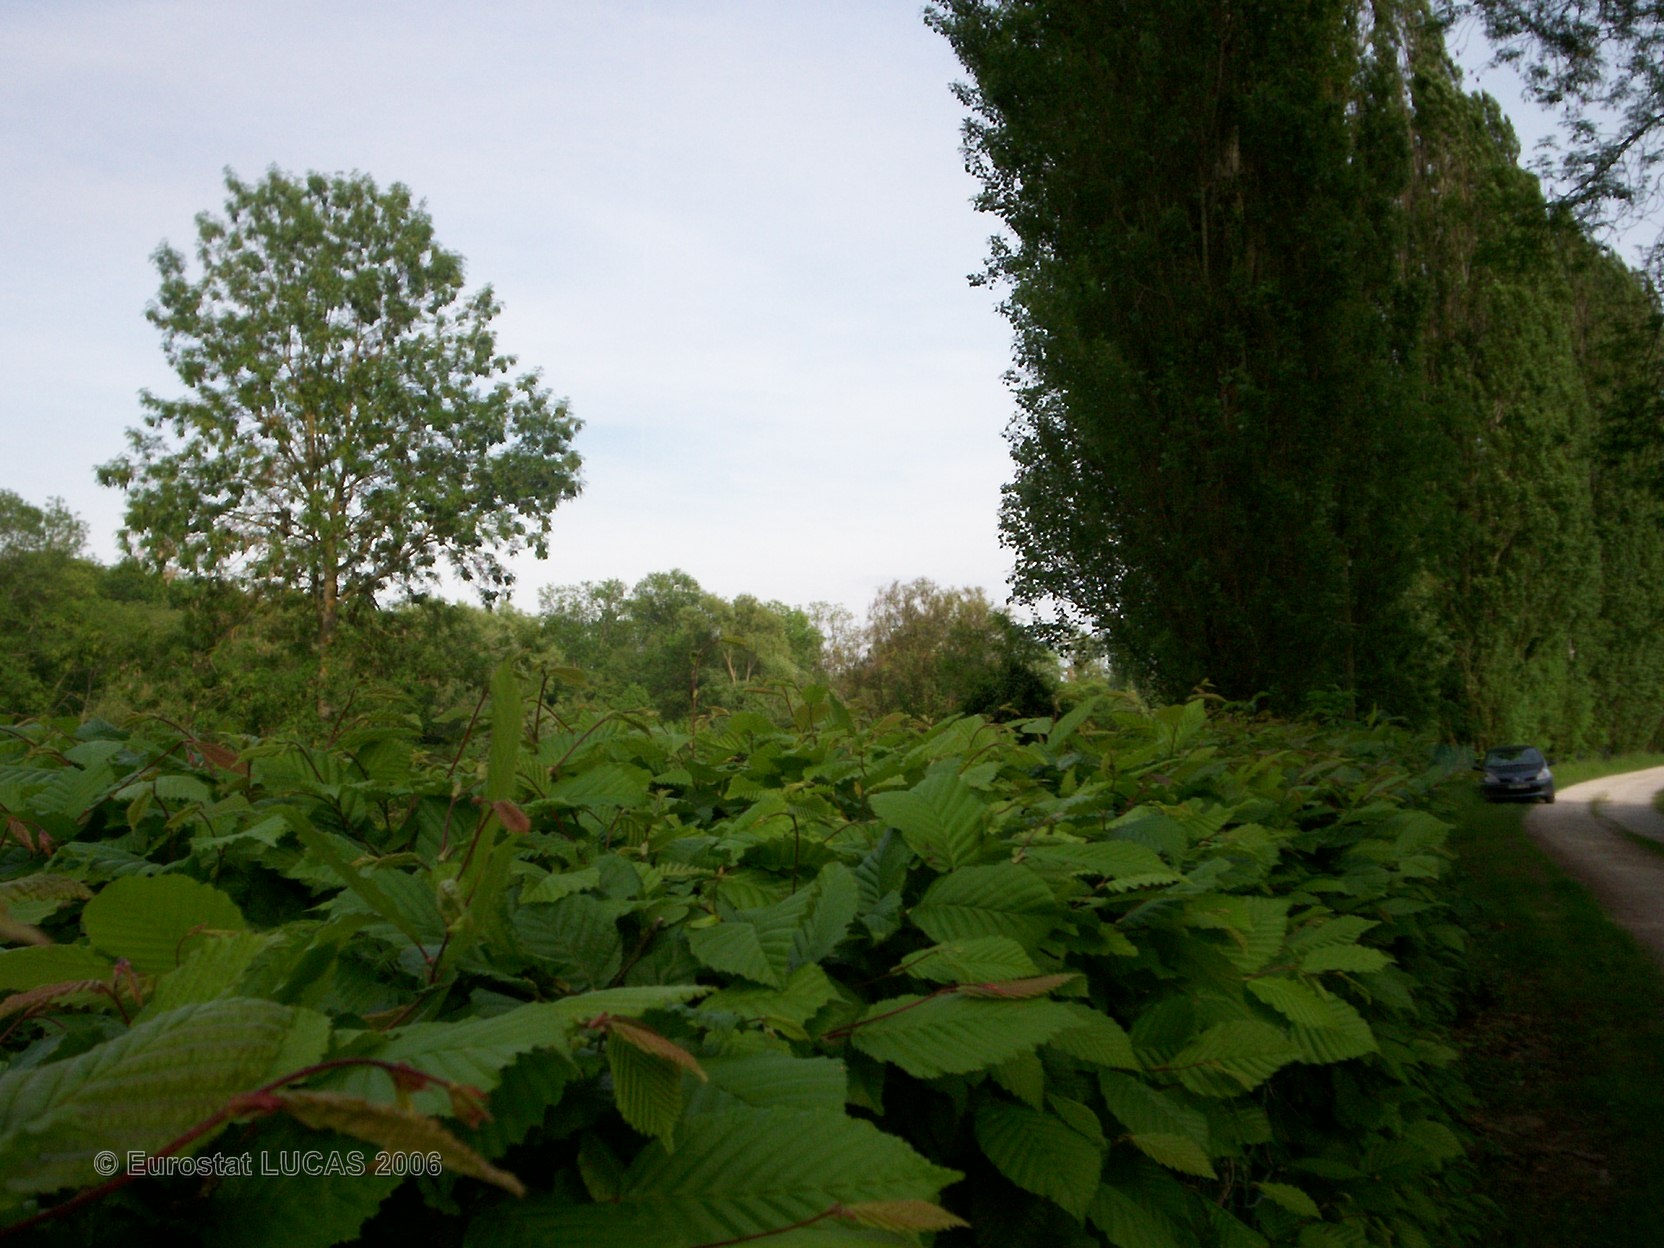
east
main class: Grassland
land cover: Grassland with sparse tree/shrub cover
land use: Residential
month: May
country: FR
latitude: 48.5854
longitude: 2.8195
